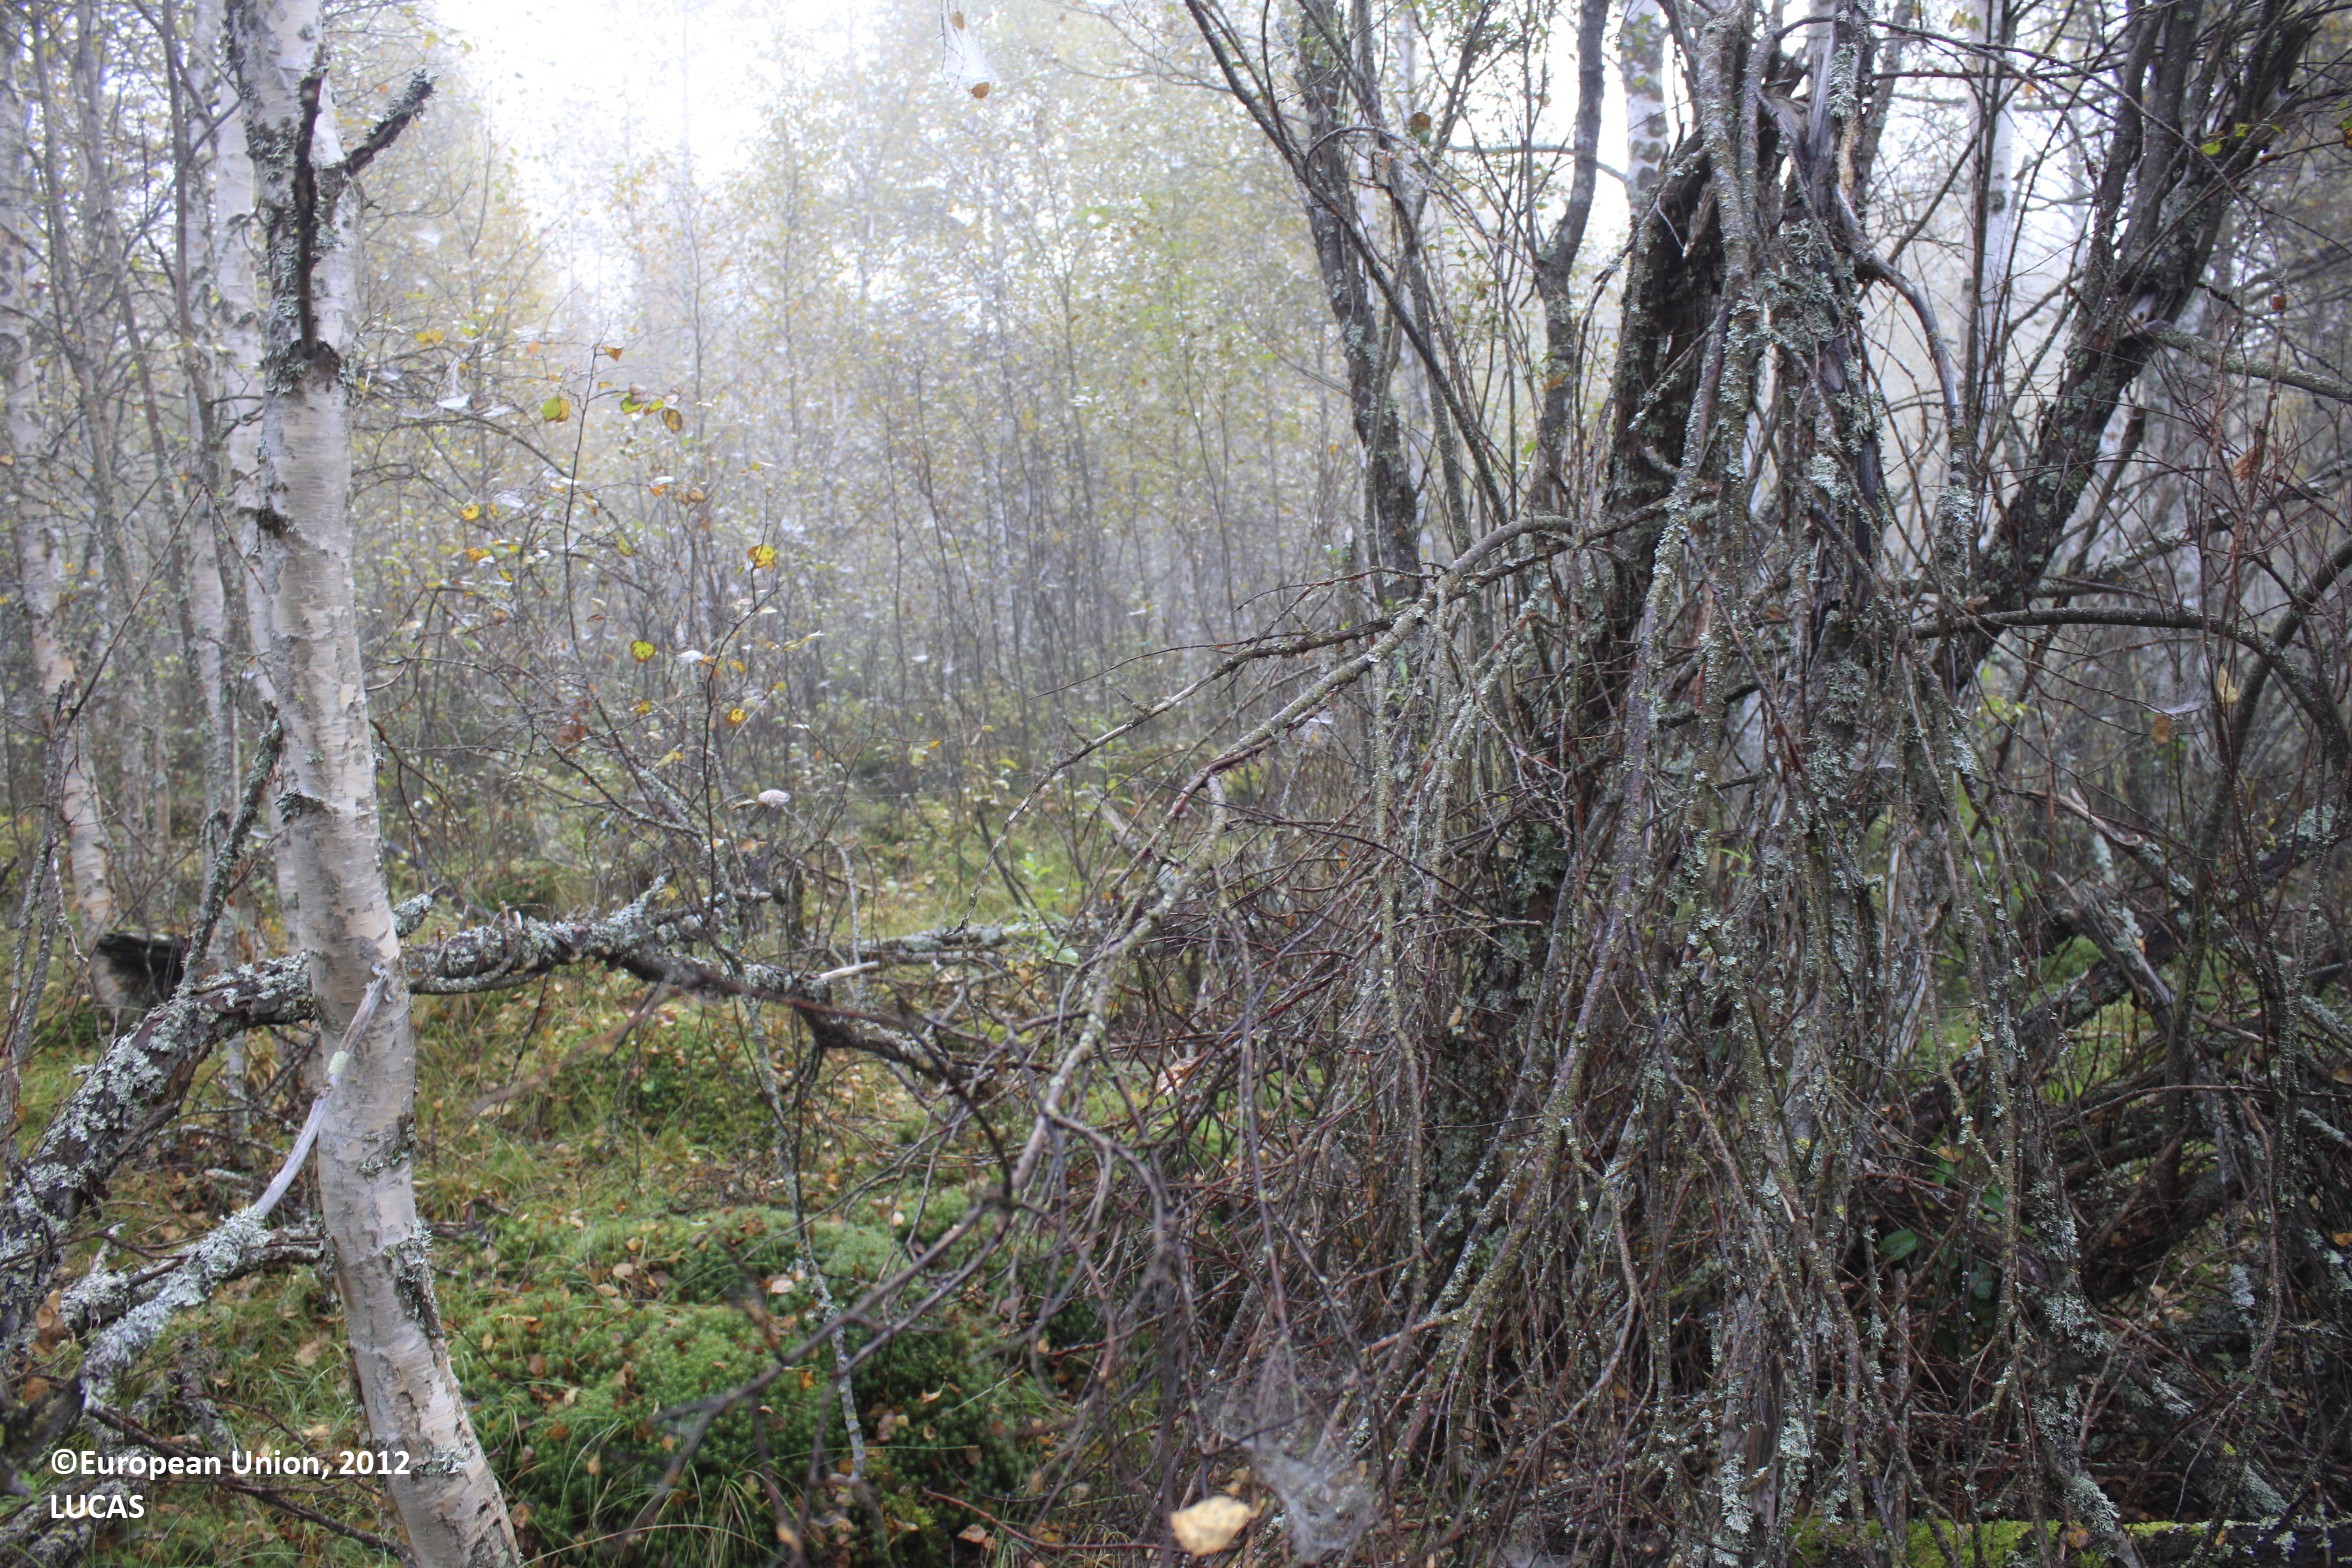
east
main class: Woodland
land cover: Broadleaved woodland
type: non-riverine alder, birch or aspen forest
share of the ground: 50 - 75 %
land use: Forestry
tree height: > 5 m
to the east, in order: Broadleaved woodland; Ditches and canals; Broadleaved woodland; Ditches and canals; Broadleaved woodland; Ditches and canals; Pine dominated mixed woodland; Electric lines; Ditches and canals; Pine dominated mixed woodland; Ditches and canals; Pine dominated mixed woodland
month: September
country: FI
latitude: 65.1924
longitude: 26.8837
